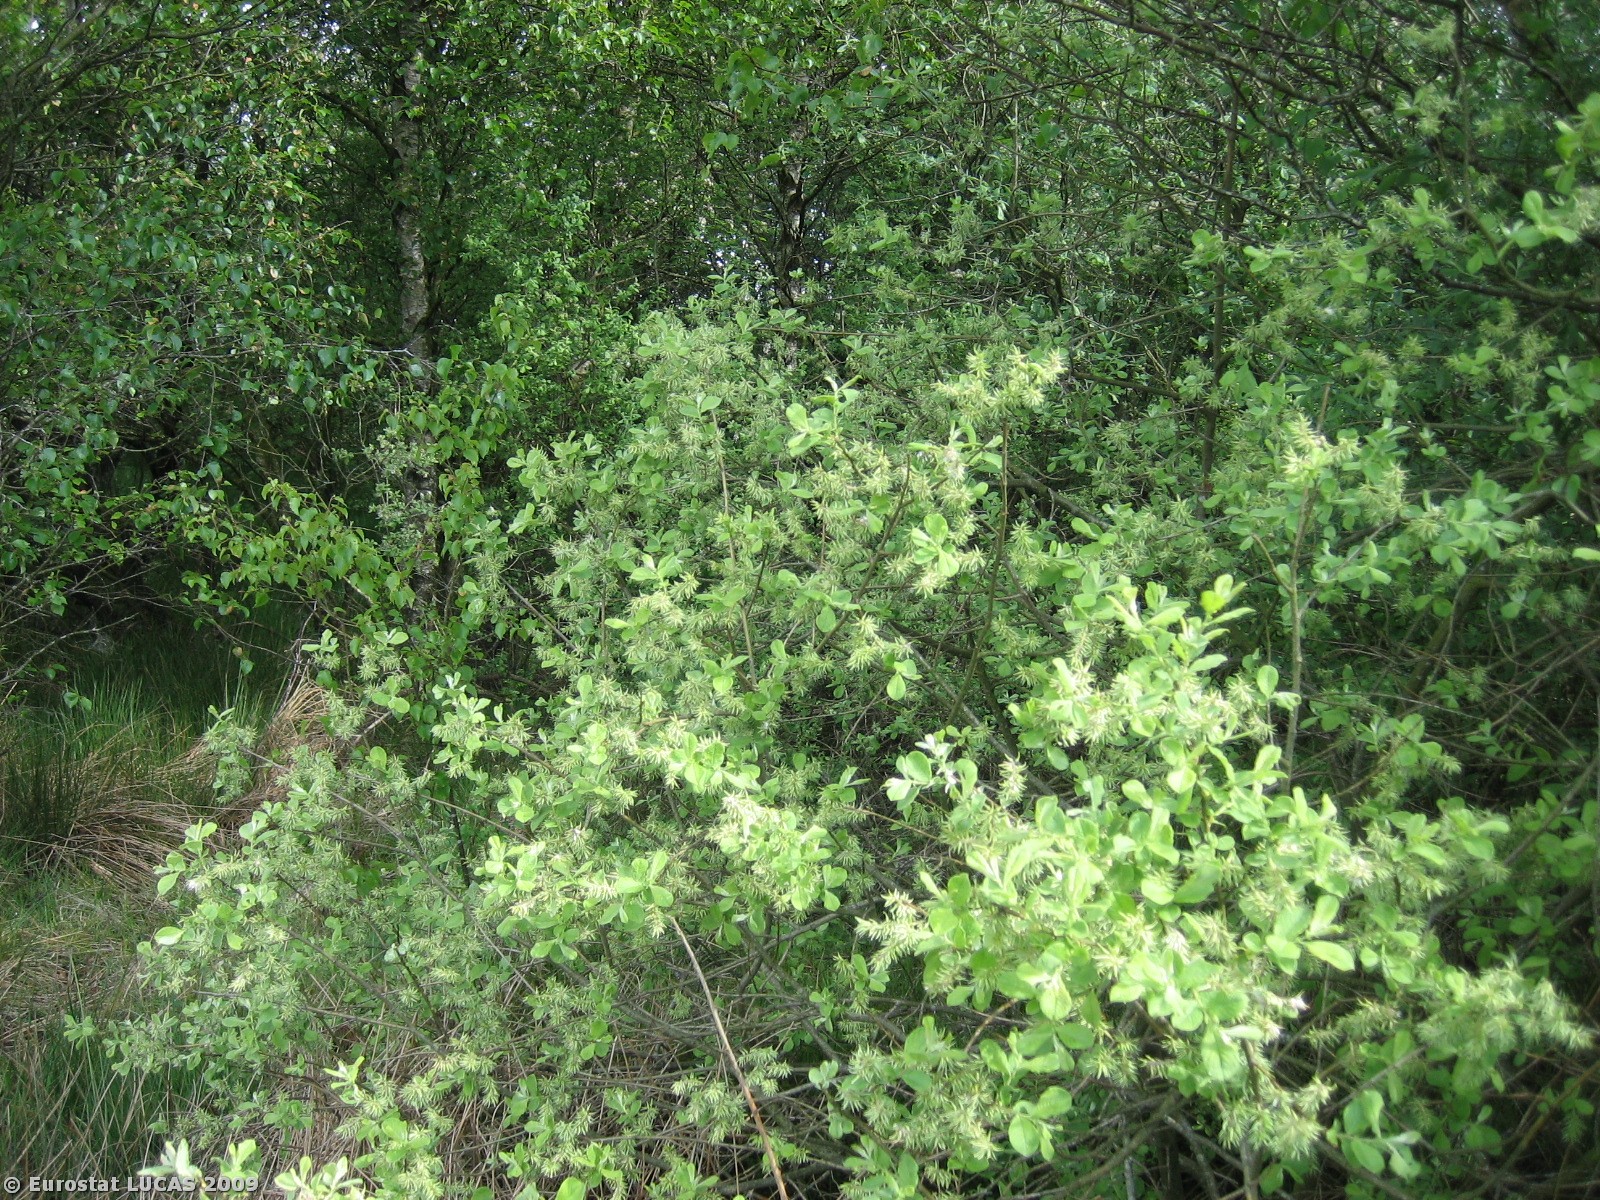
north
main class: Shrubland
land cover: Shrubland with sparse tree cover
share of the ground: > 75 %
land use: Unused
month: May
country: DK
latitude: 56.0928
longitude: 8.8601
